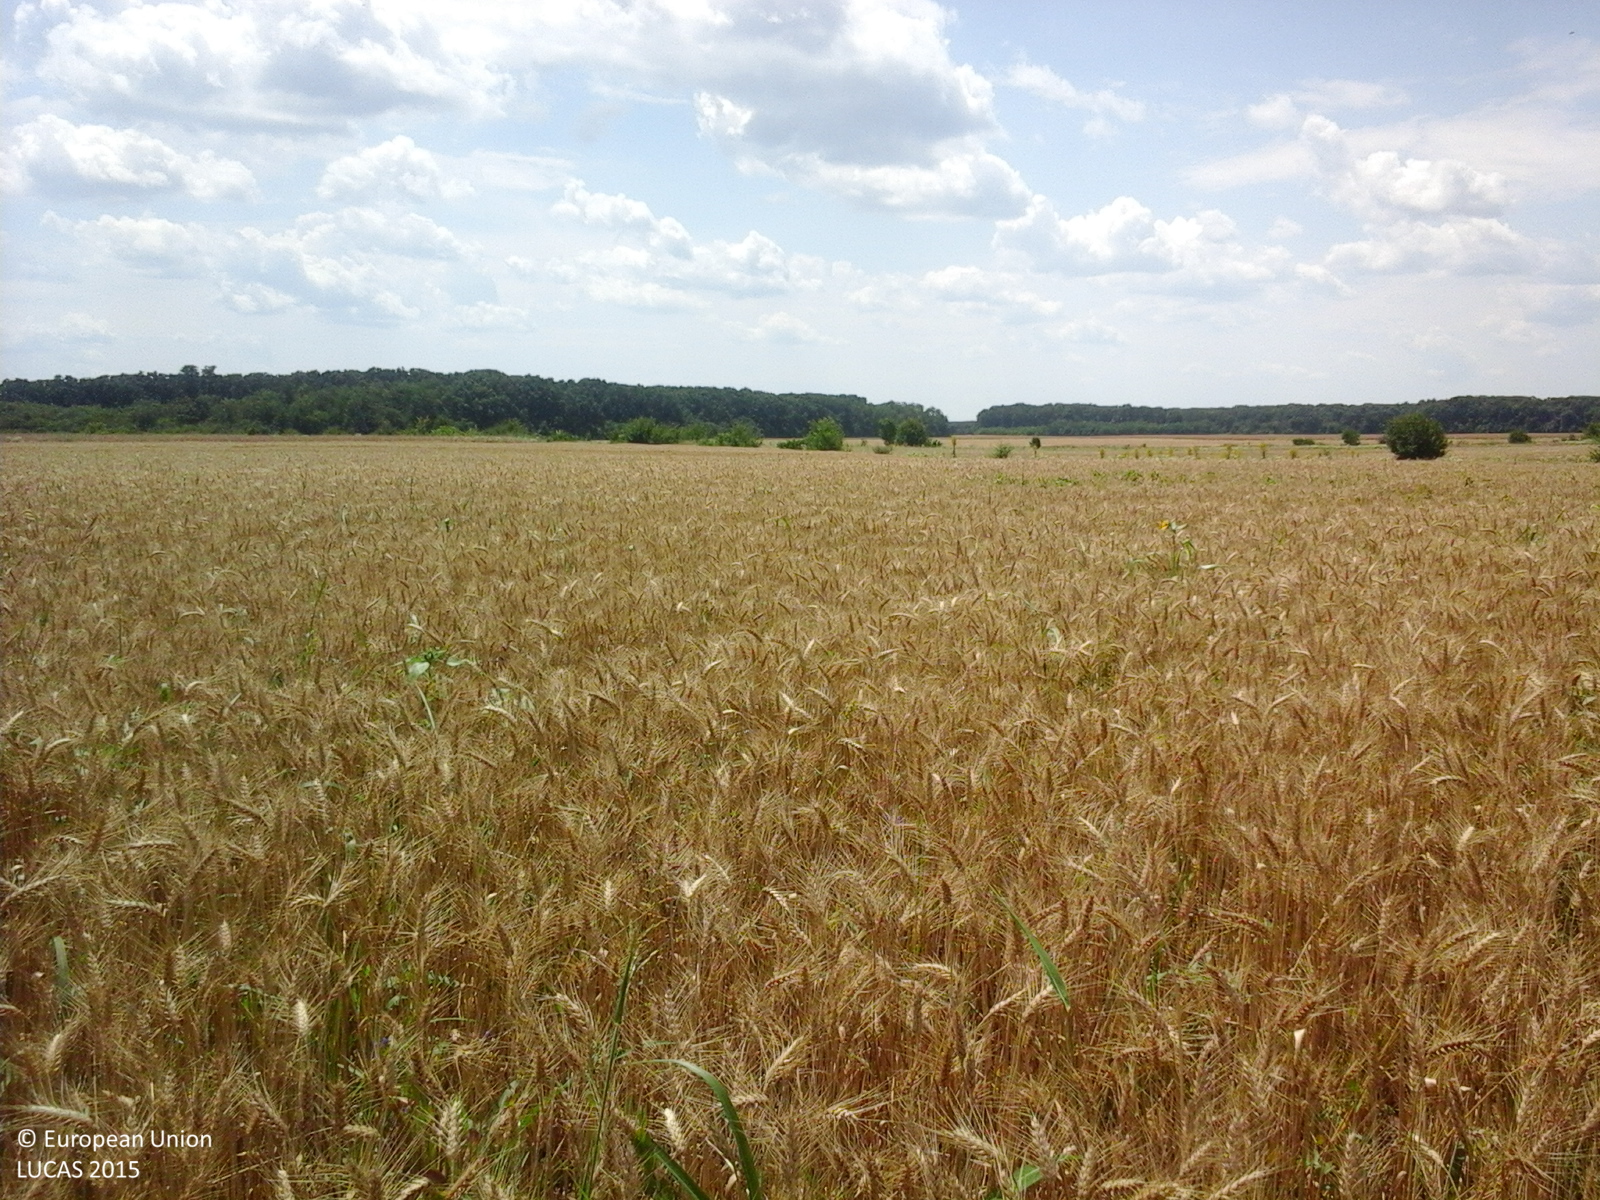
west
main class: Cropland
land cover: Common wheat
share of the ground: > 75 %
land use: Agriculture (excluding fallow land and kitchen gardens)
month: June
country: RO
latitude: 44.6431
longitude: 26.3394
